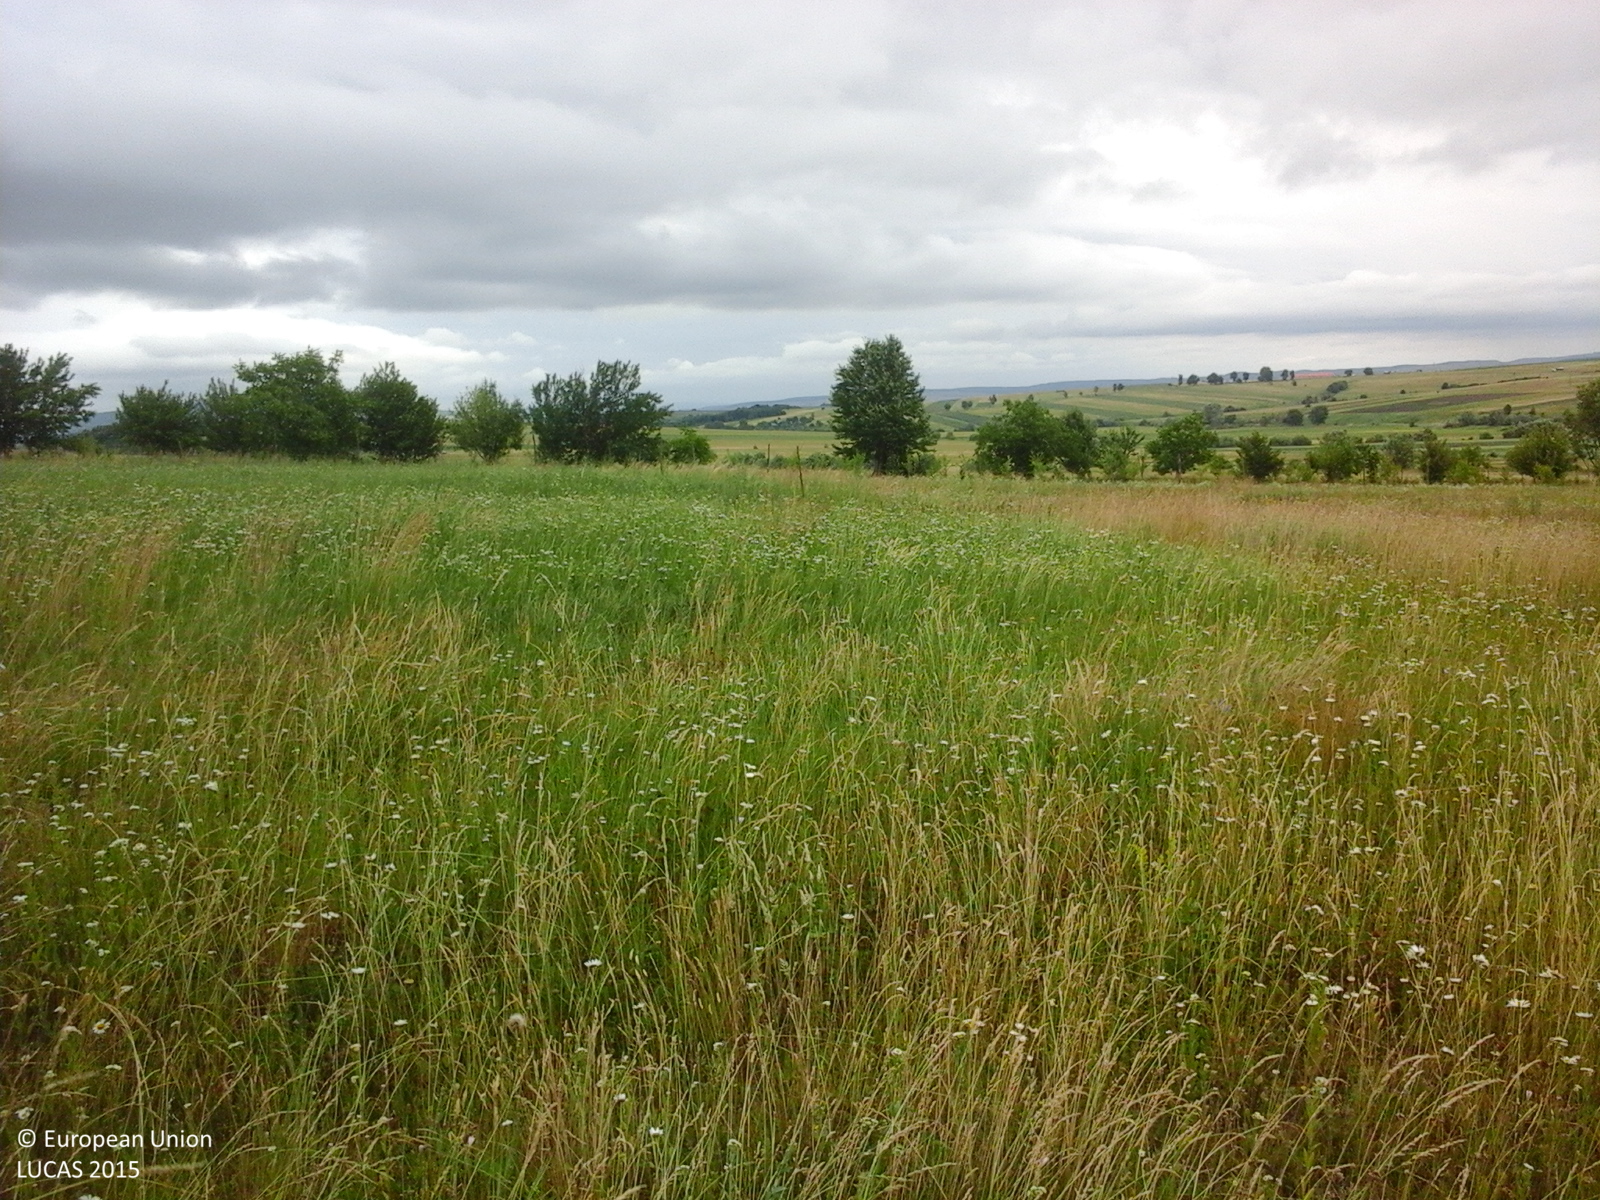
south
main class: Grassland
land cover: Grassland without tree/shrub cover
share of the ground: > 75 %
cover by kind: herbaceous plants 100 %
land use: Agriculture (excluding fallow land and kitchen gardens)
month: June
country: RO
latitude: 47.1656
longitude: 26.2939
